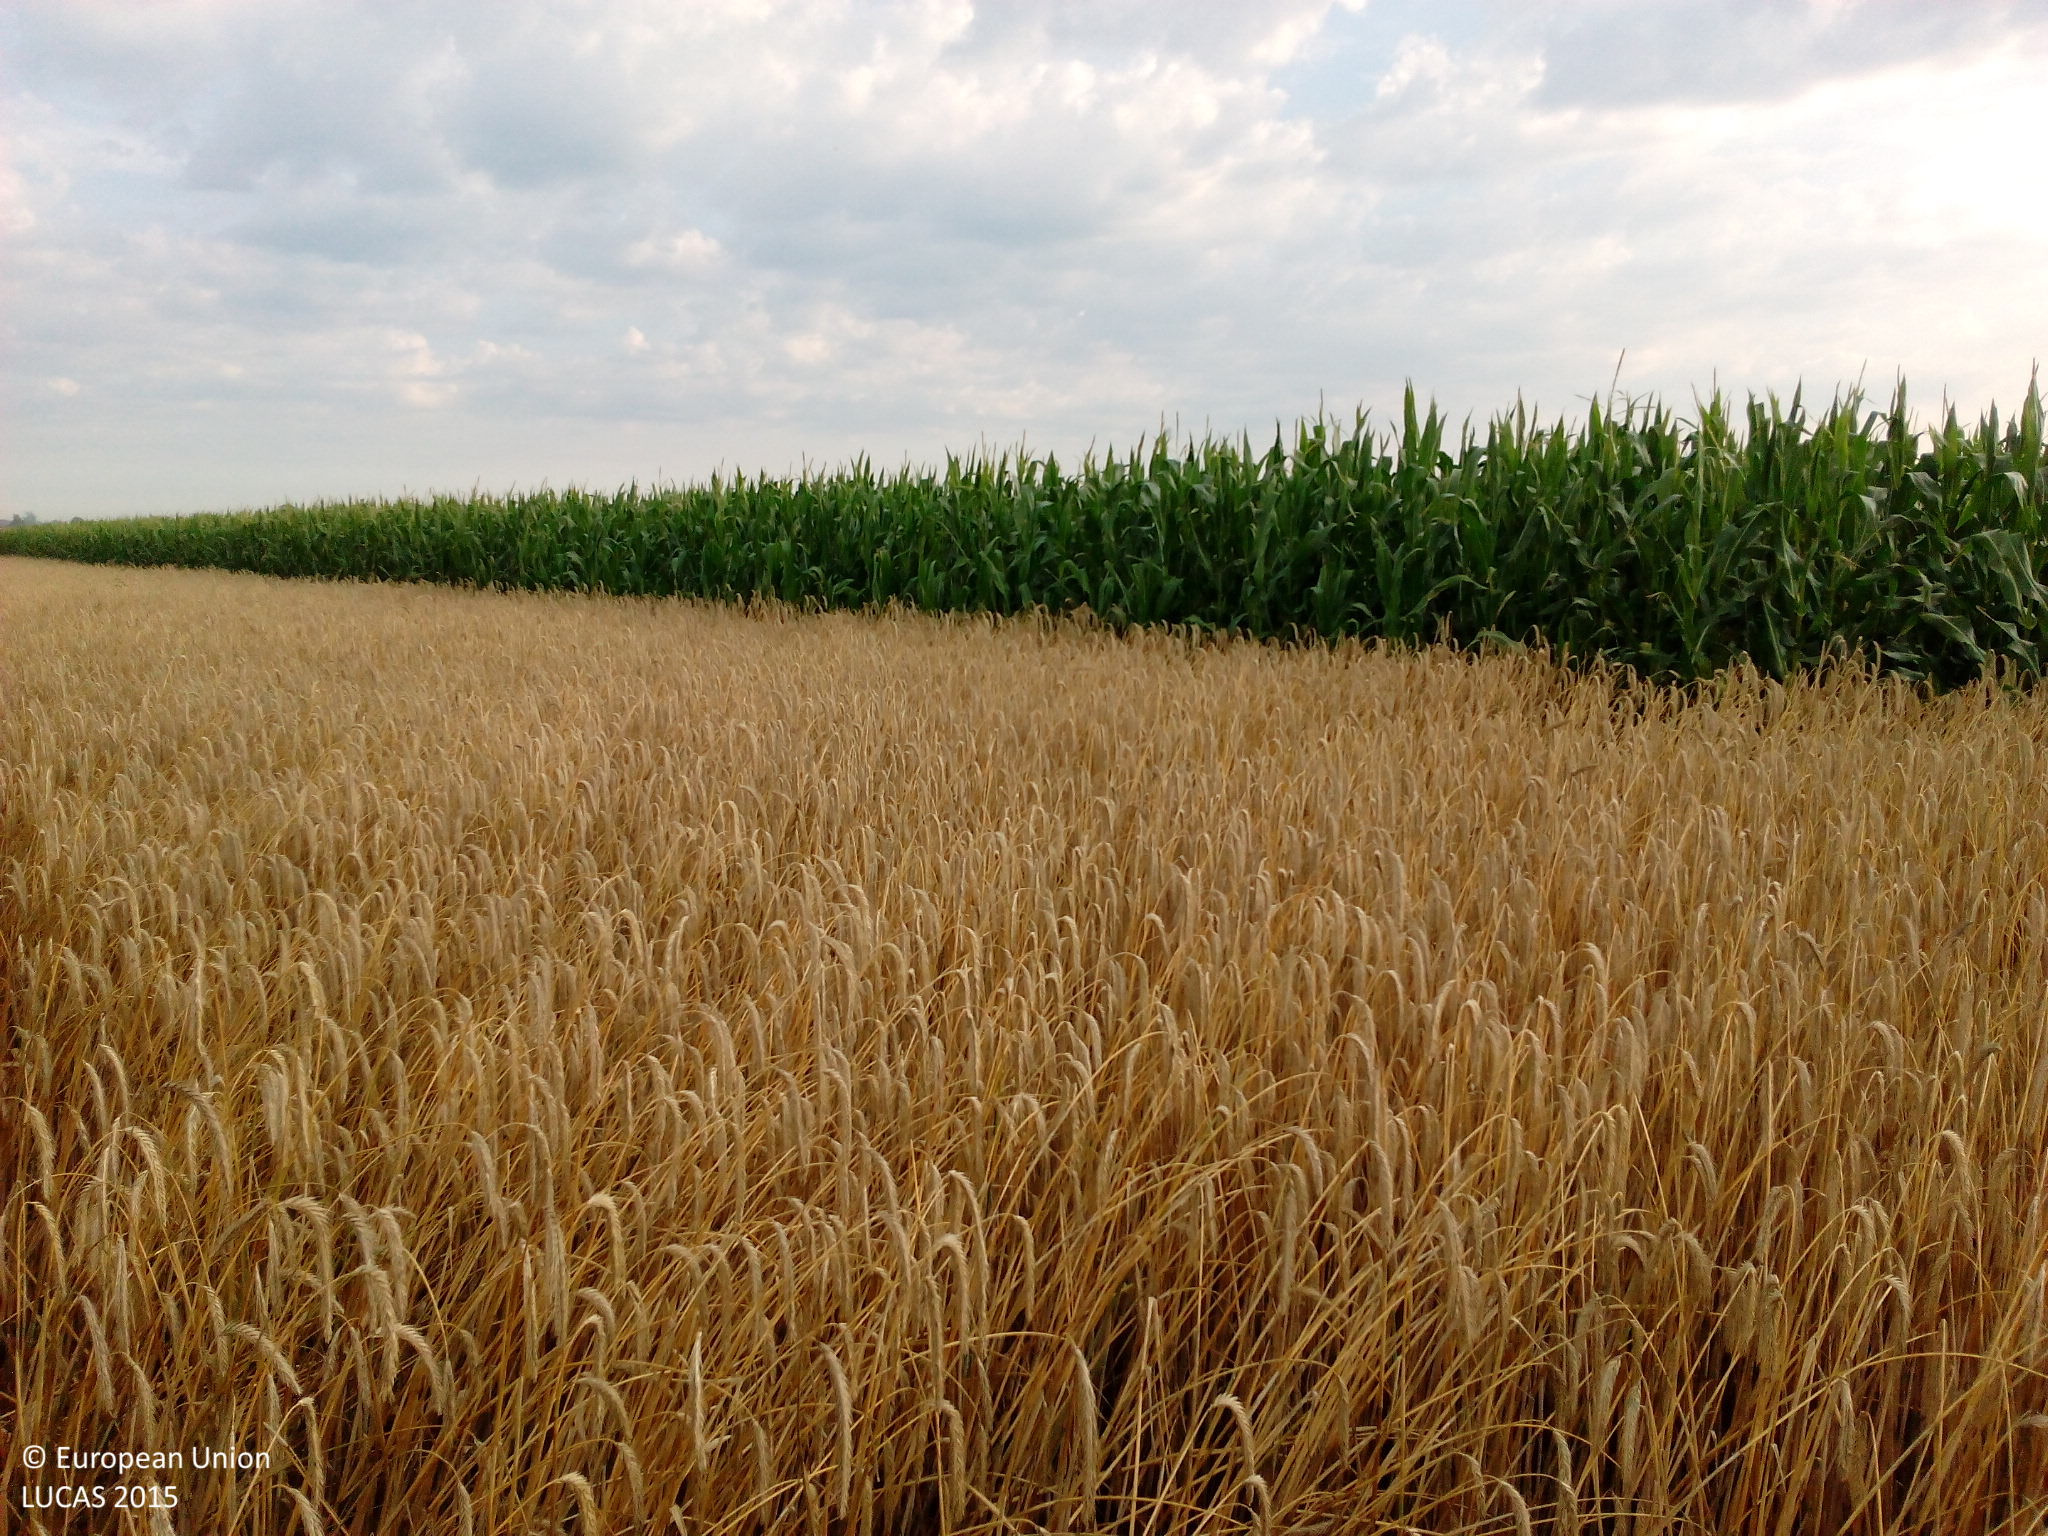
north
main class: Cropland
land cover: Rye
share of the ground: > 75 %
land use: Agriculture (excluding fallow land and kitchen gardens)
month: August
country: DE
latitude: 53.9046
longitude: 9.6501
